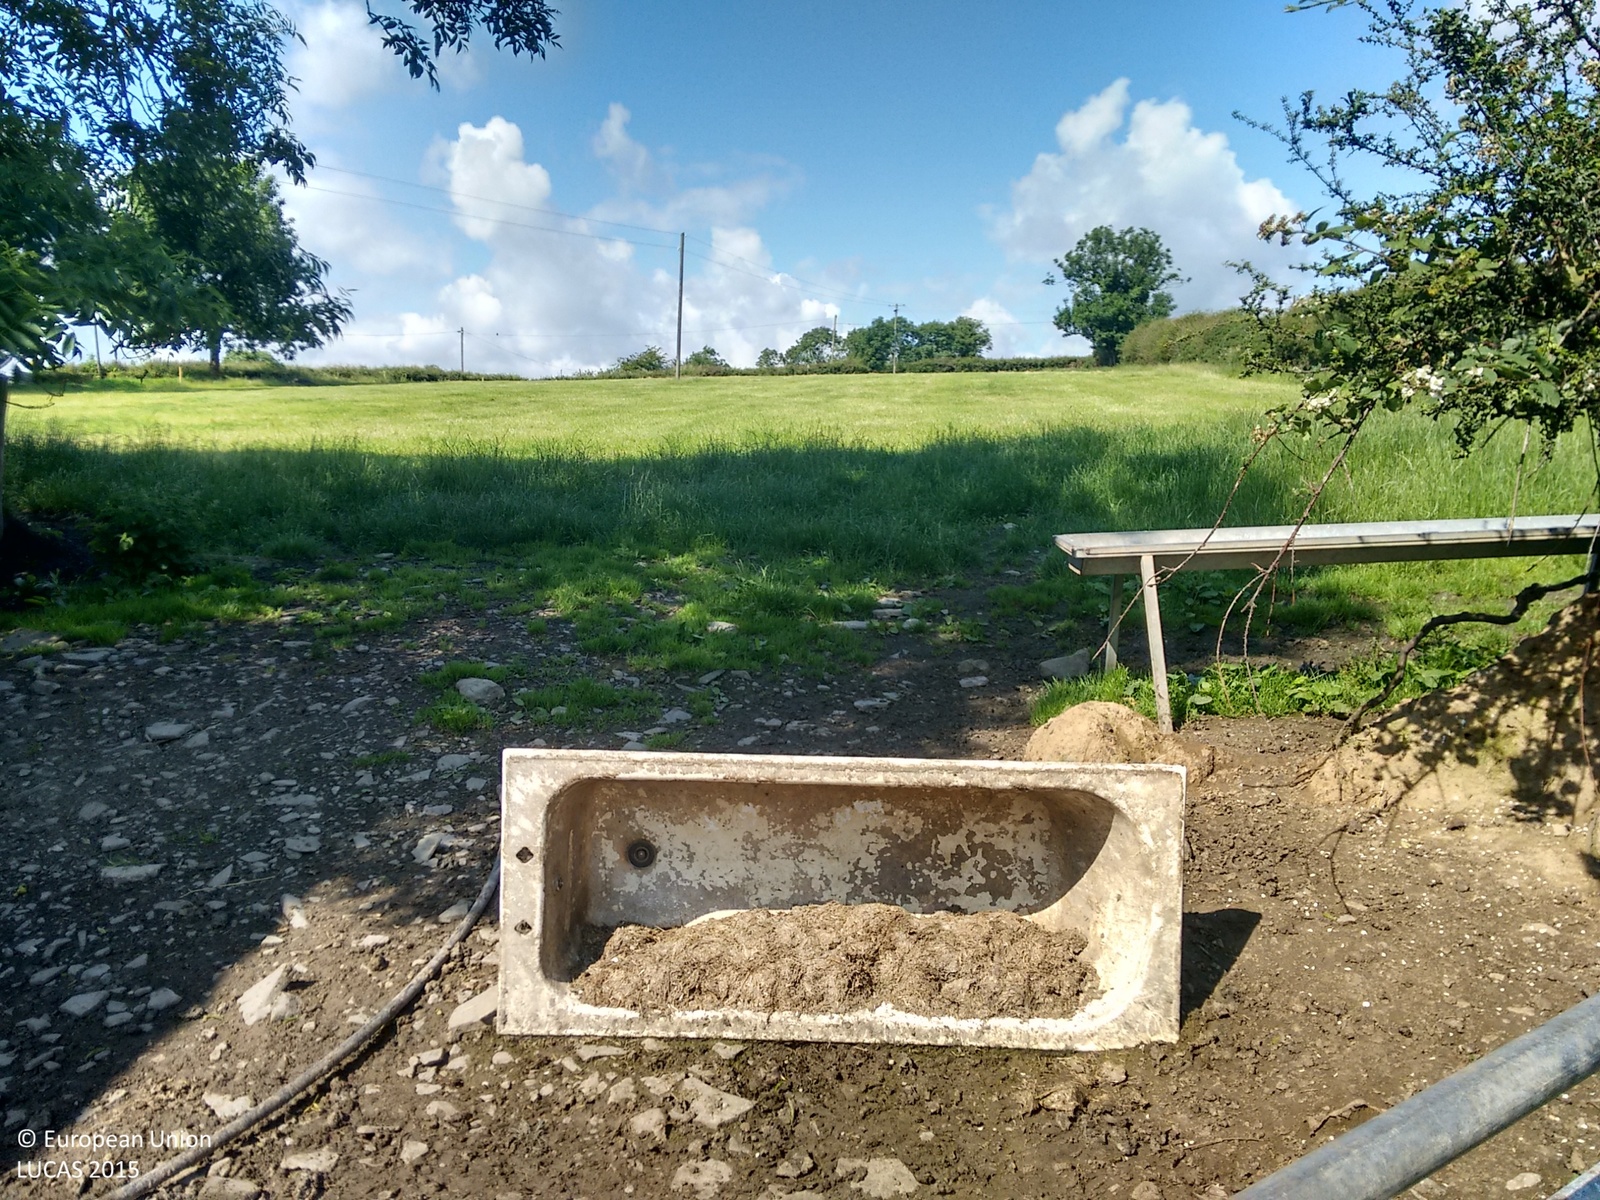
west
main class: Grassland
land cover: Grassland without tree/shrub cover
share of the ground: > 75 %
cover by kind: herbaceous plants 100 %
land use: Agriculture (excluding fallow land and kitchen gardens)
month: July
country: IE
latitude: 52.6129
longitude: -7.6042
